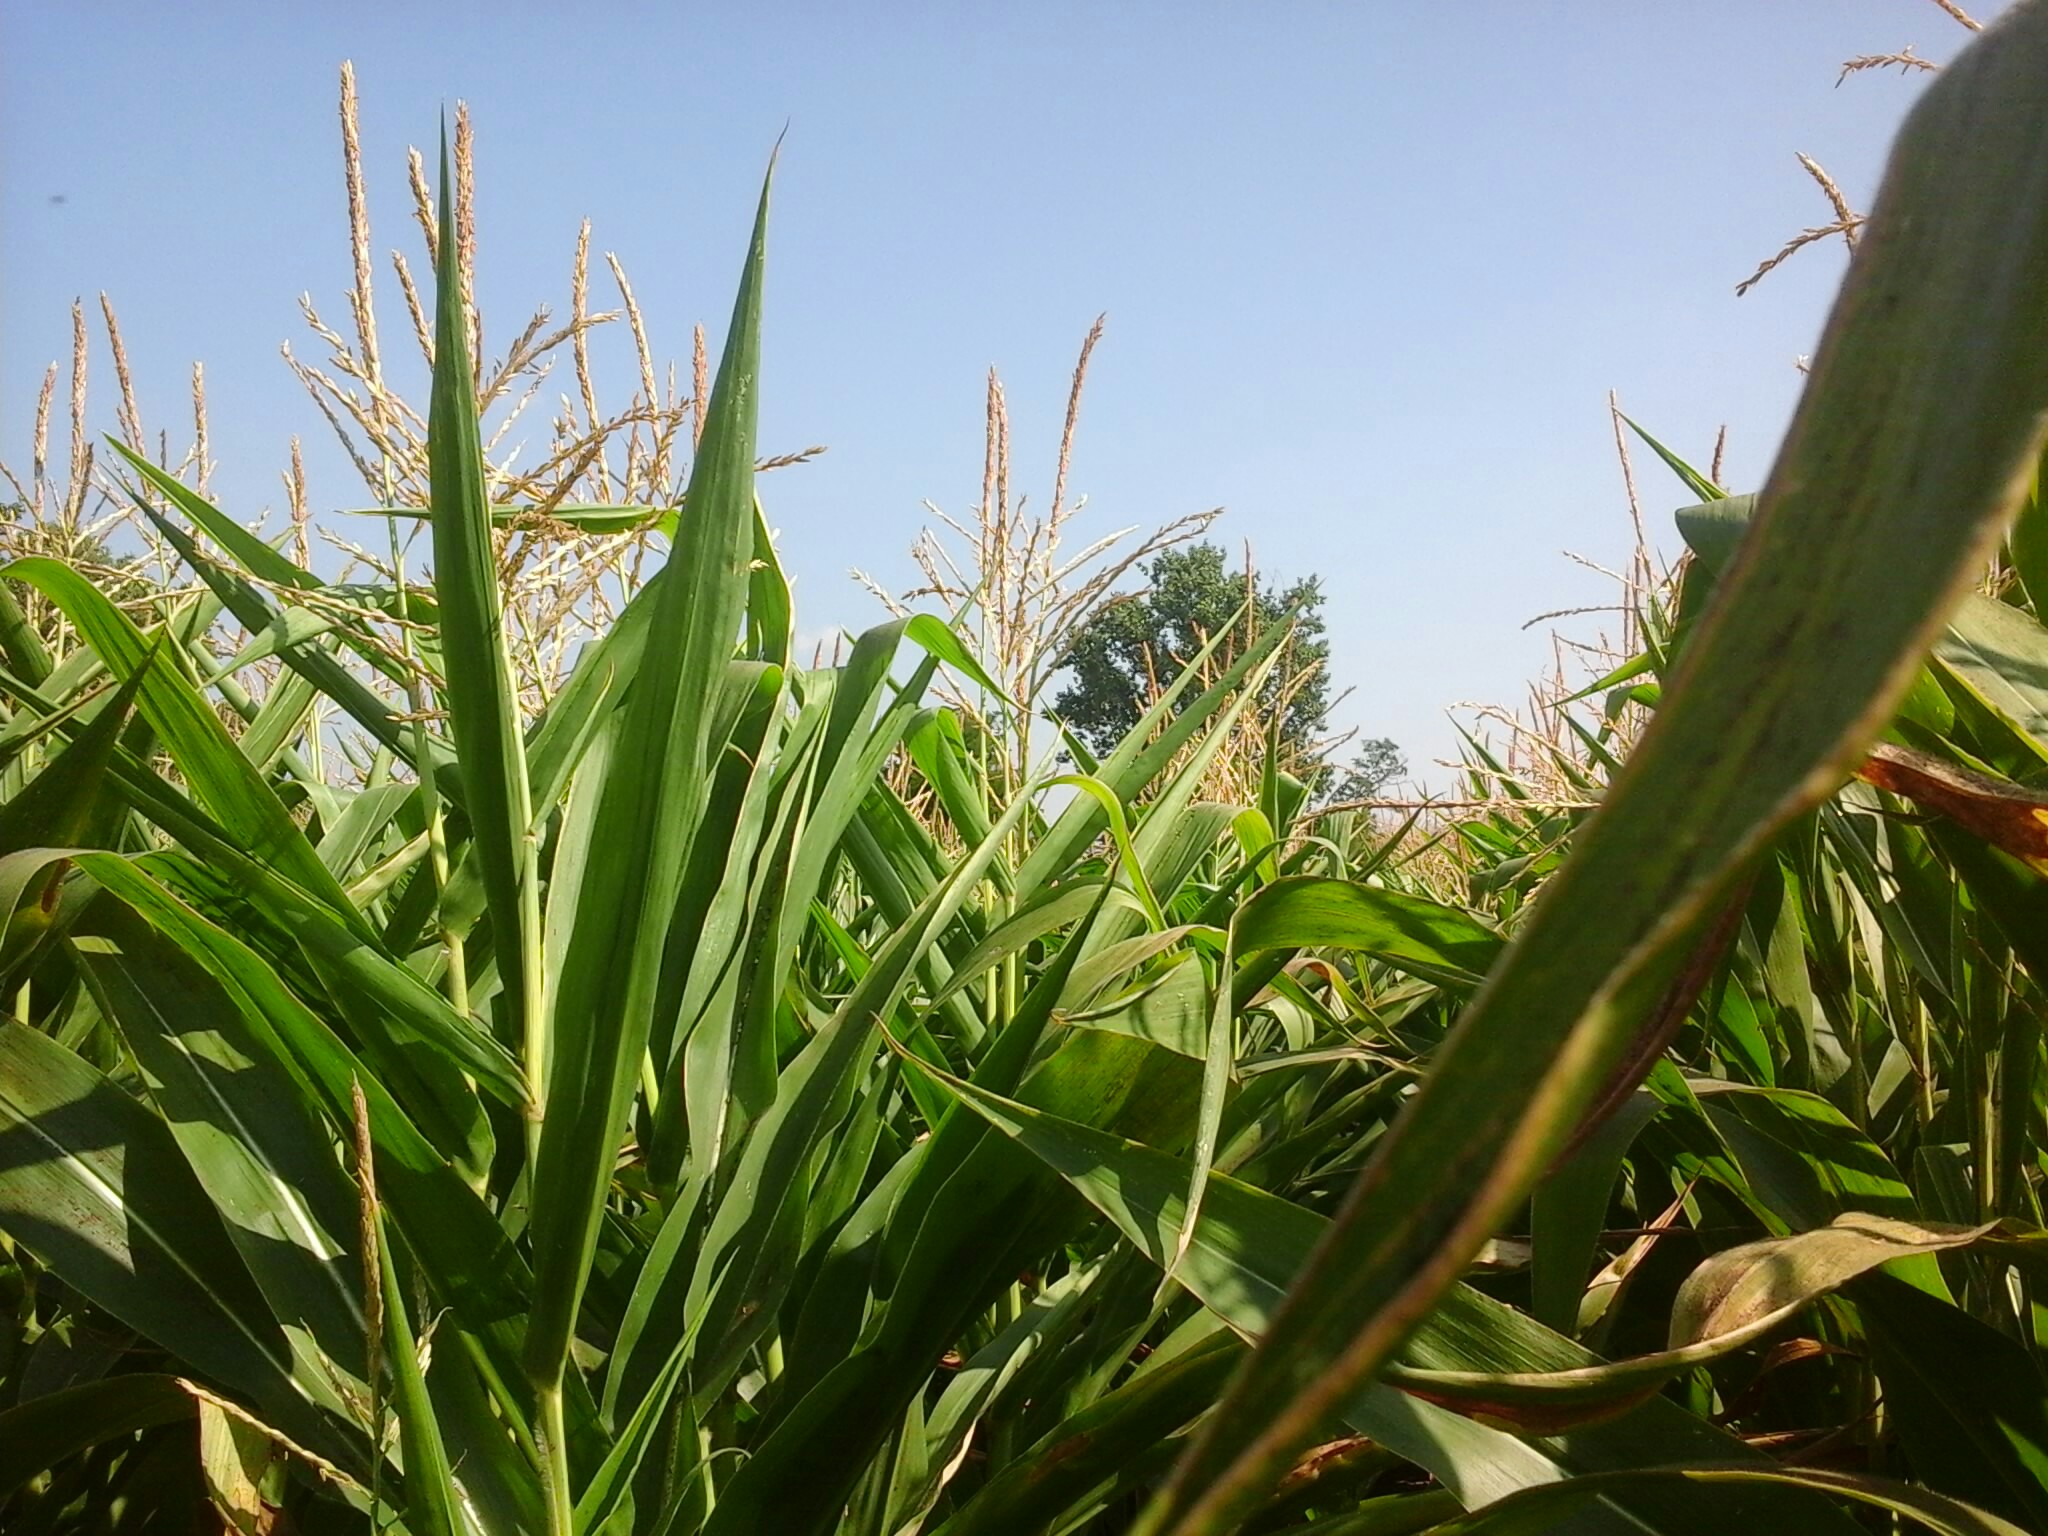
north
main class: Cropland
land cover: Maize
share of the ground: > 75 %
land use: Agriculture (excluding fallow land and kitchen gardens)
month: August
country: HU
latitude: 47.6501
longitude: 17.9053
